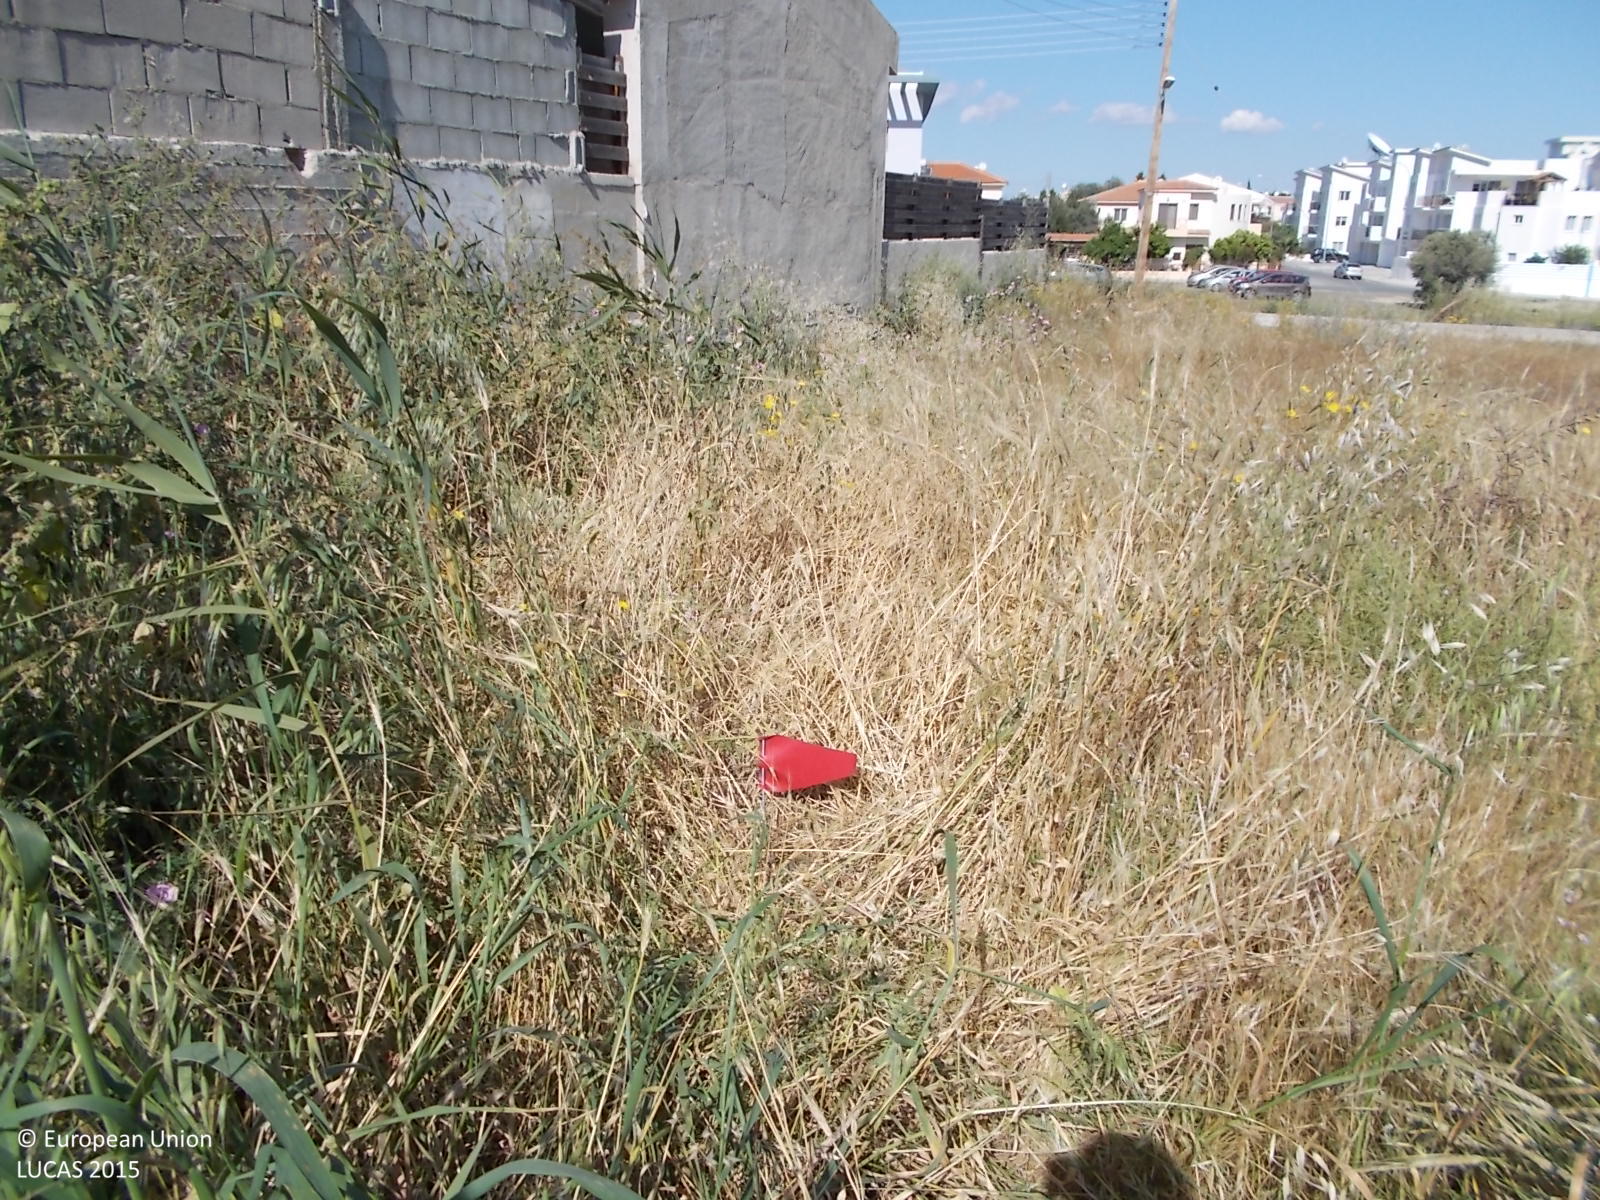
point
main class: Grassland
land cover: Grassland without tree/shrub cover
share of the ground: > 75 %
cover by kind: herbaceous plants 100 %
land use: Residential
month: April
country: CY
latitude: 34.9813
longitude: 33.6527
